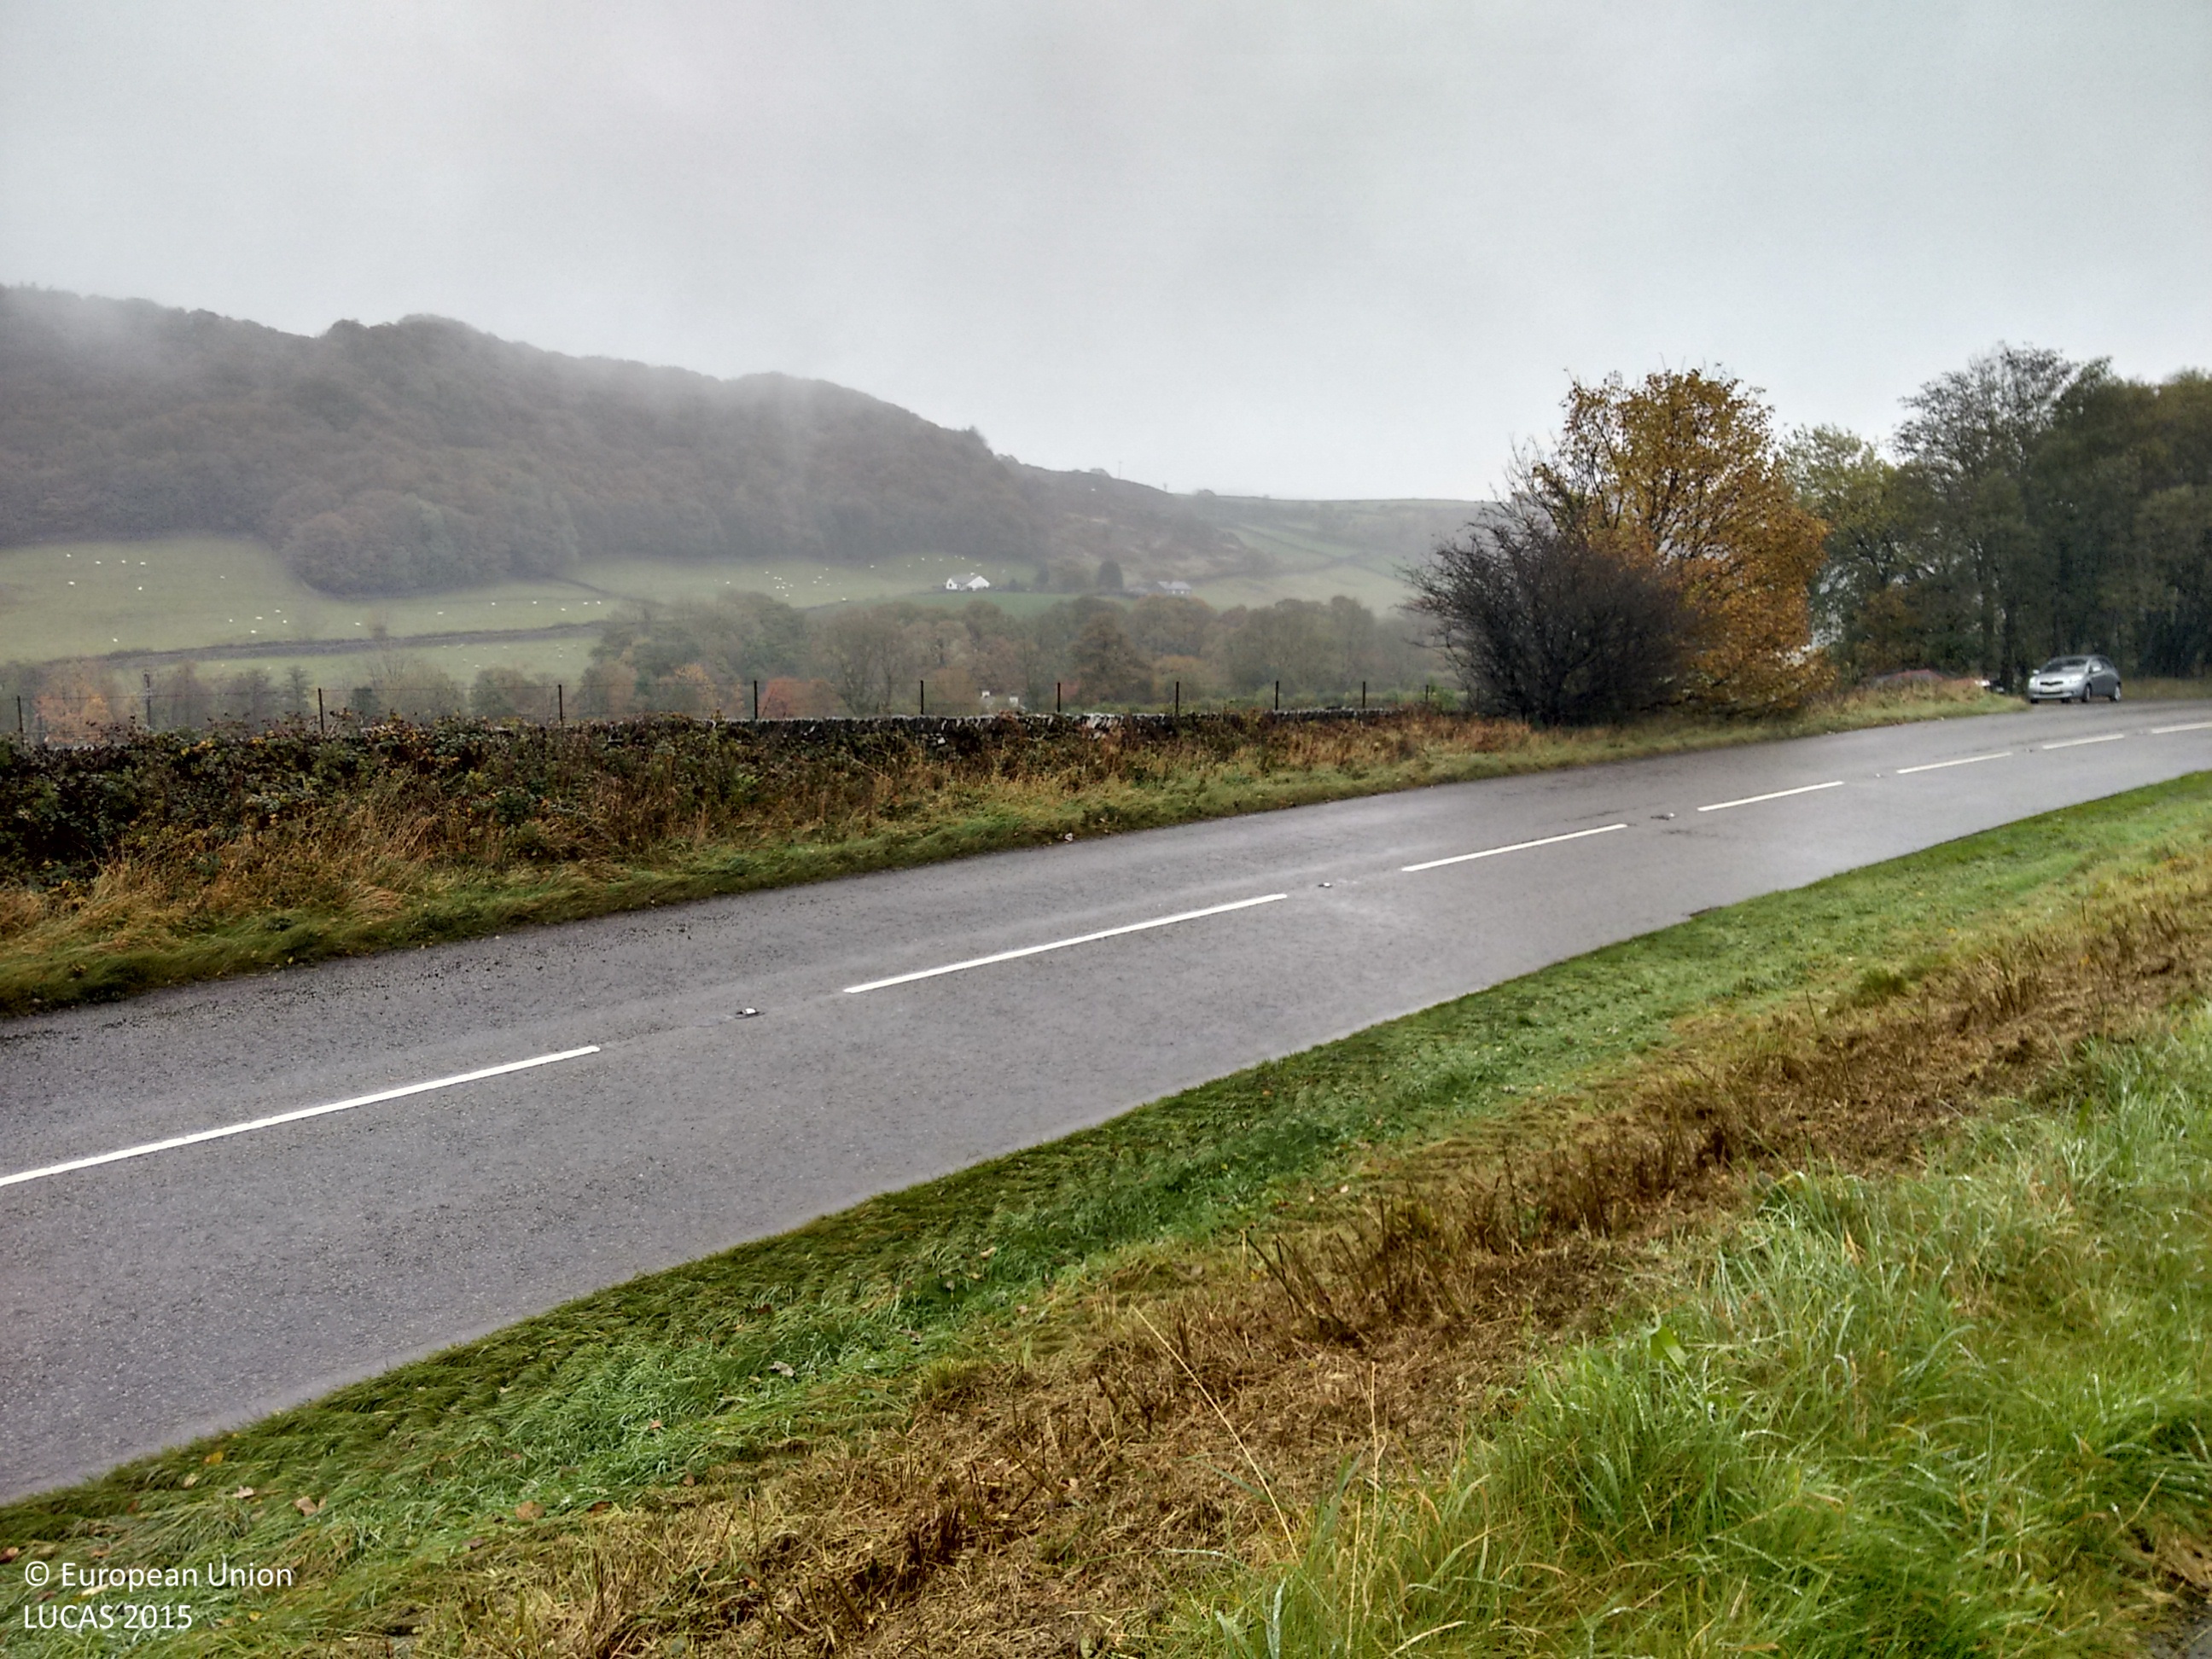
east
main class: Grassland
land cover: Grassland without tree/shrub cover
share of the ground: > 75 %
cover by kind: herbaceous plants 100 %
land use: Agriculture (excluding fallow land and kitchen gardens)
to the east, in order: Grassland without tree/shrub cover; Fences; Dry stone walls; Grass margins; Paved roads, cycling and walking lanes; Grass margins; Dry stone walls; Fences; Grassland without tree/shrub cover; Managed hedges; Grassland without tree/shrub cover; Fences; Grassland without tree/shrub cover; Fences; Grassland without tree/shrub cover; Managed hedges; Grassland without tree/shrub cover
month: October
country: GB
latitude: 54.2566
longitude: -3.0760
